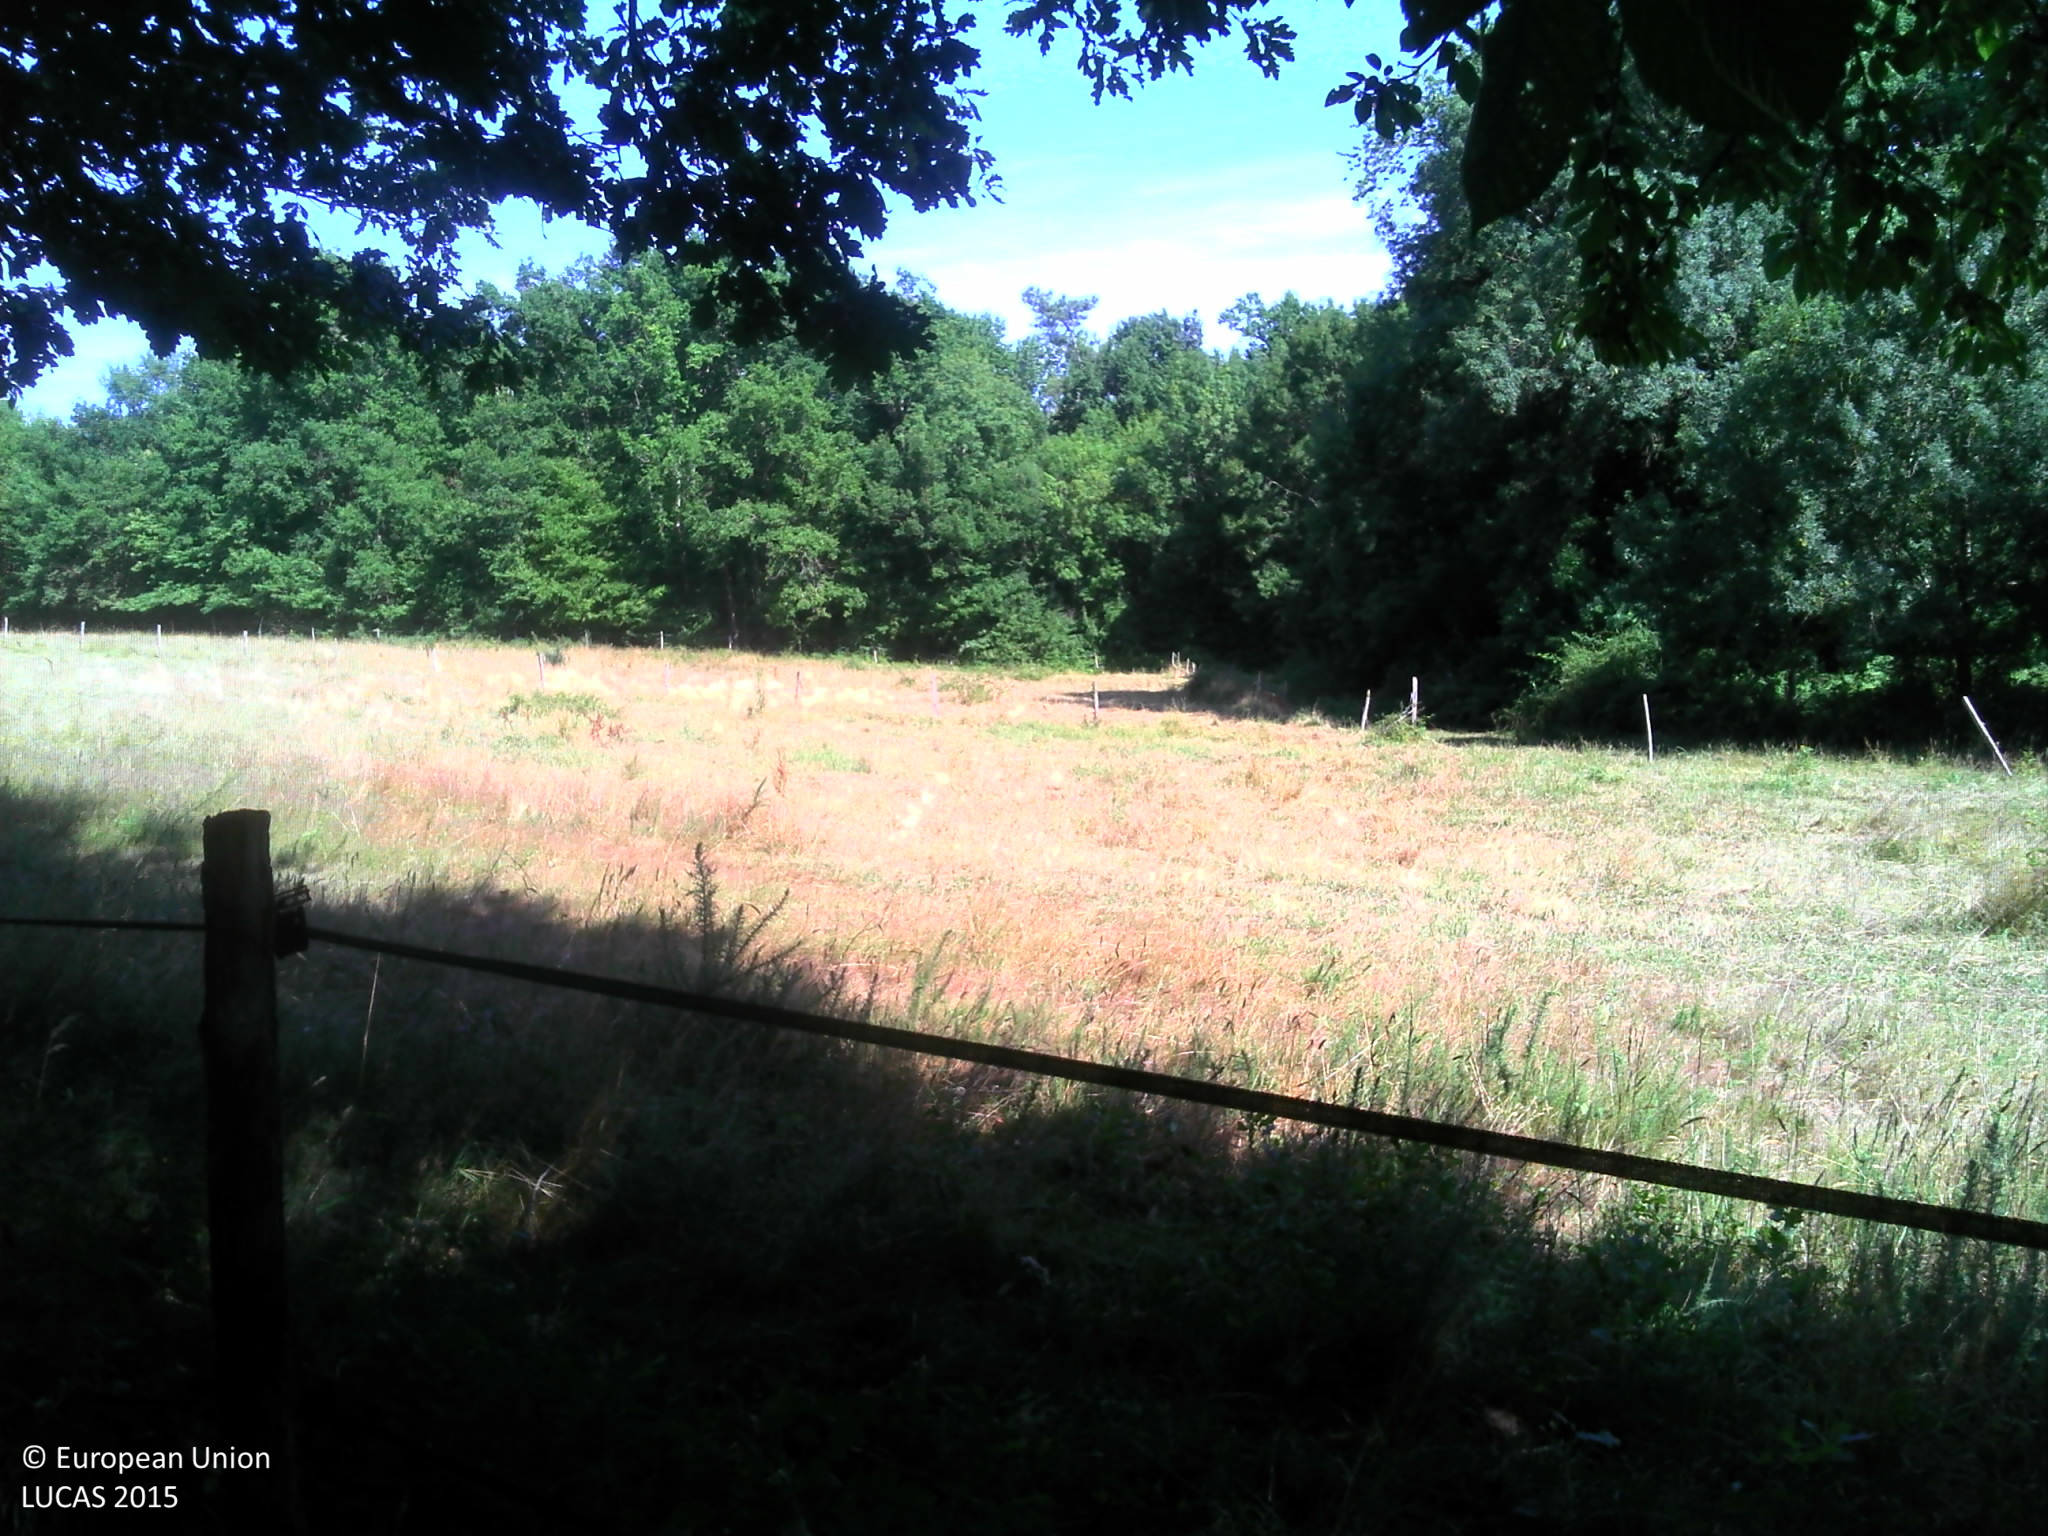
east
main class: Woodland
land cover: Broadleaved woodland
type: mesophytic deciduous forest
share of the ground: > 75 %
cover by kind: broadleaved forest trees 100 %
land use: Forestry
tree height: > 5 m
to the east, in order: Broadleaved woodland; Fences; Grassland without tree/shrub cover; Fences; Grassland without tree/shrub cover; Fences; Broadleaved woodland
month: July
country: FR
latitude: 45.3556
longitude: -0.5524
